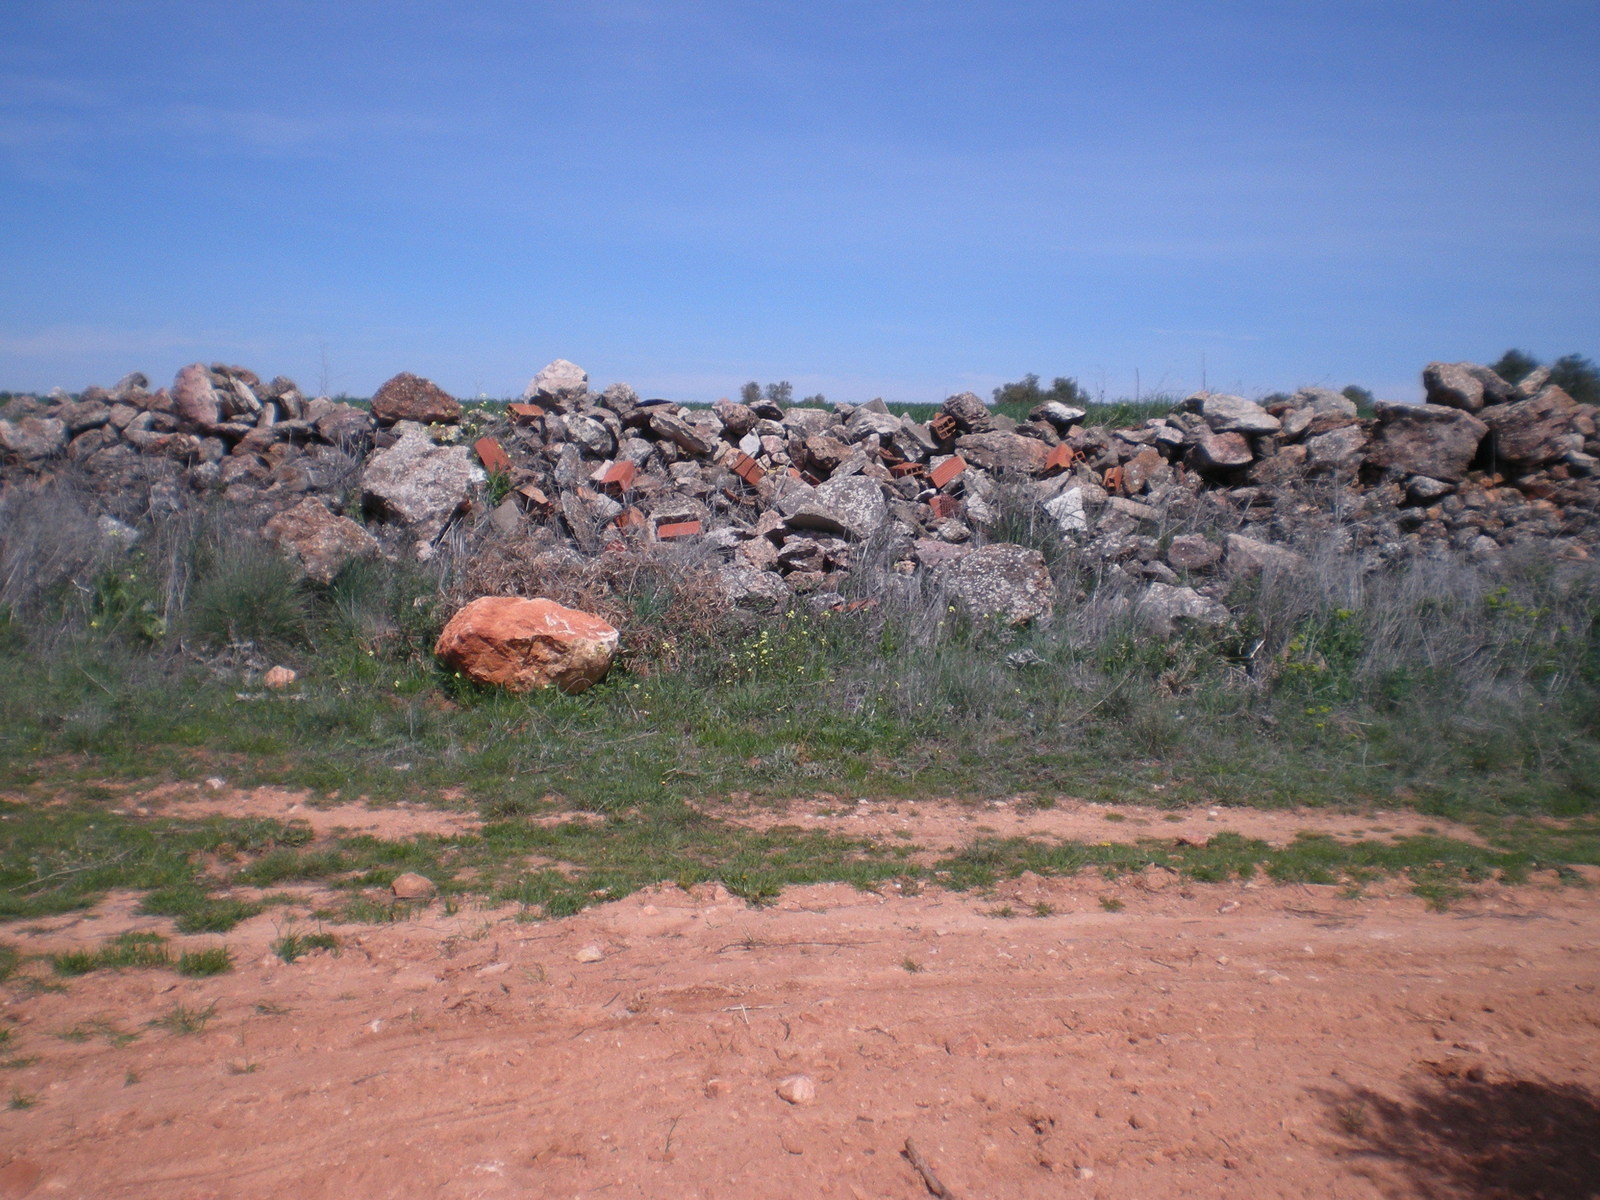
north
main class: Cropland
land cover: Olive groves
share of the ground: 10 - 25 %
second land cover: Other bare soil
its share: > 75 %
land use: Agriculture (excluding fallow land and kitchen gardens)
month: March
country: ES
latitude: 38.9677
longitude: -3.2039
